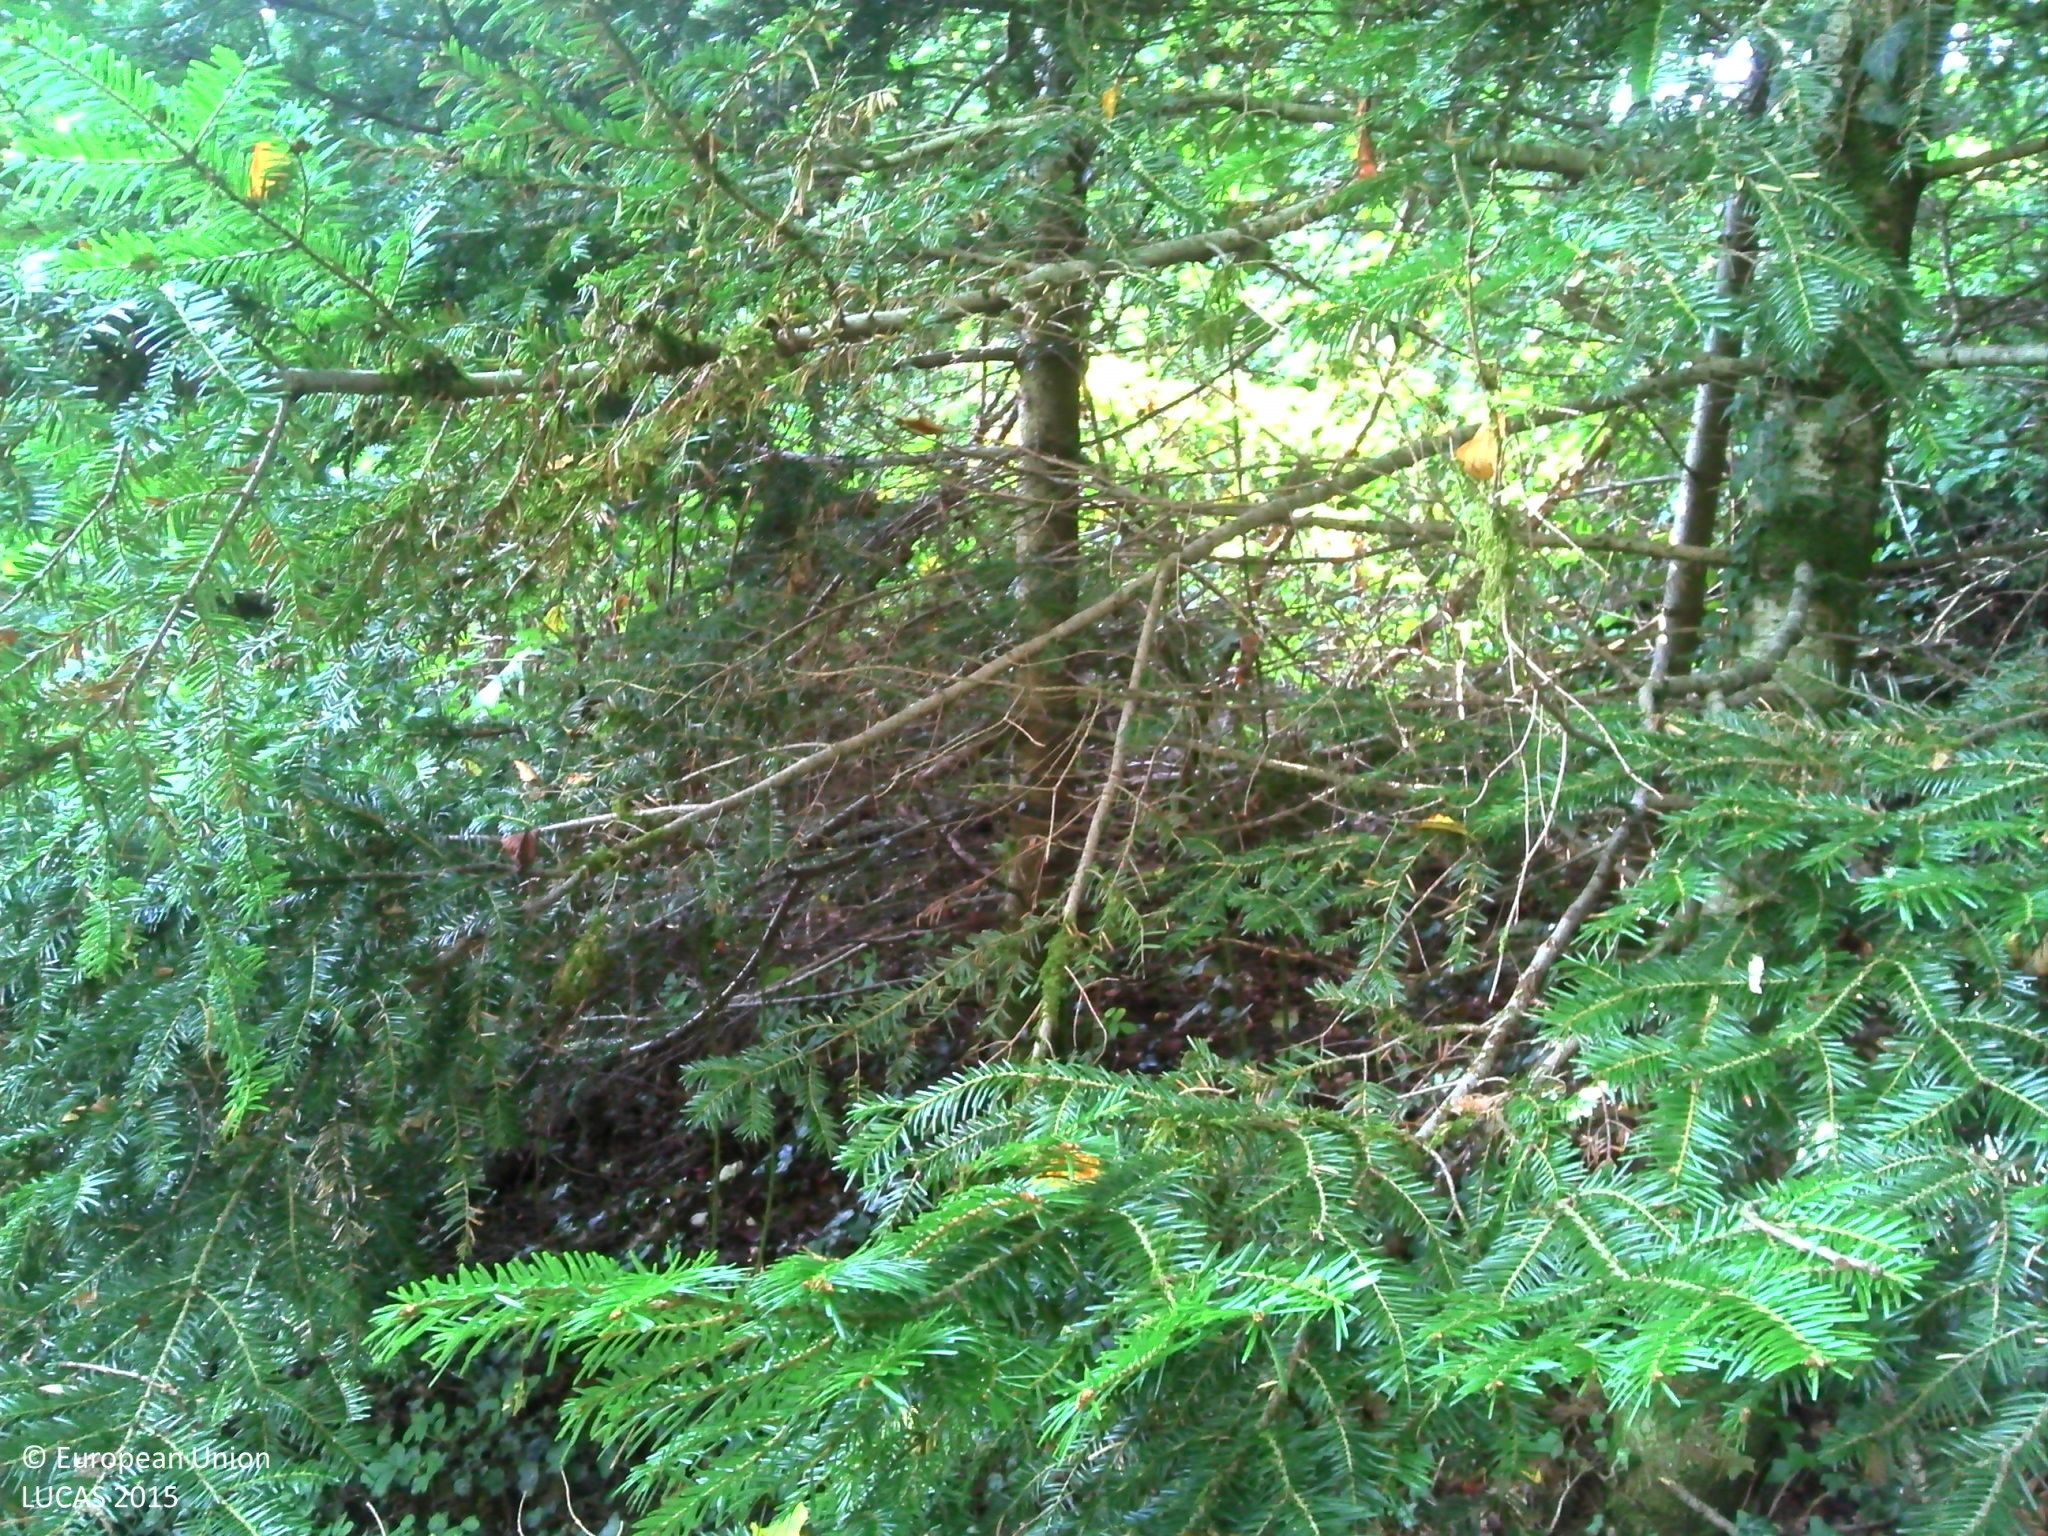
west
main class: Woodland
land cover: Spruce dominated mixed woodland
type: hemiboreal forest and nemoral coniferous forest and mixed broadleaved-coniferous forest
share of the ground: > 75 %
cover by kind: coniferous forest trees 50 %, broadleaved forest trees 30 %, shrubs 10 %, herbaceous plants 10 %
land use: Forestry
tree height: > 5 m
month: September
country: FR
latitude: 47.3175
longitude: 6.9724
